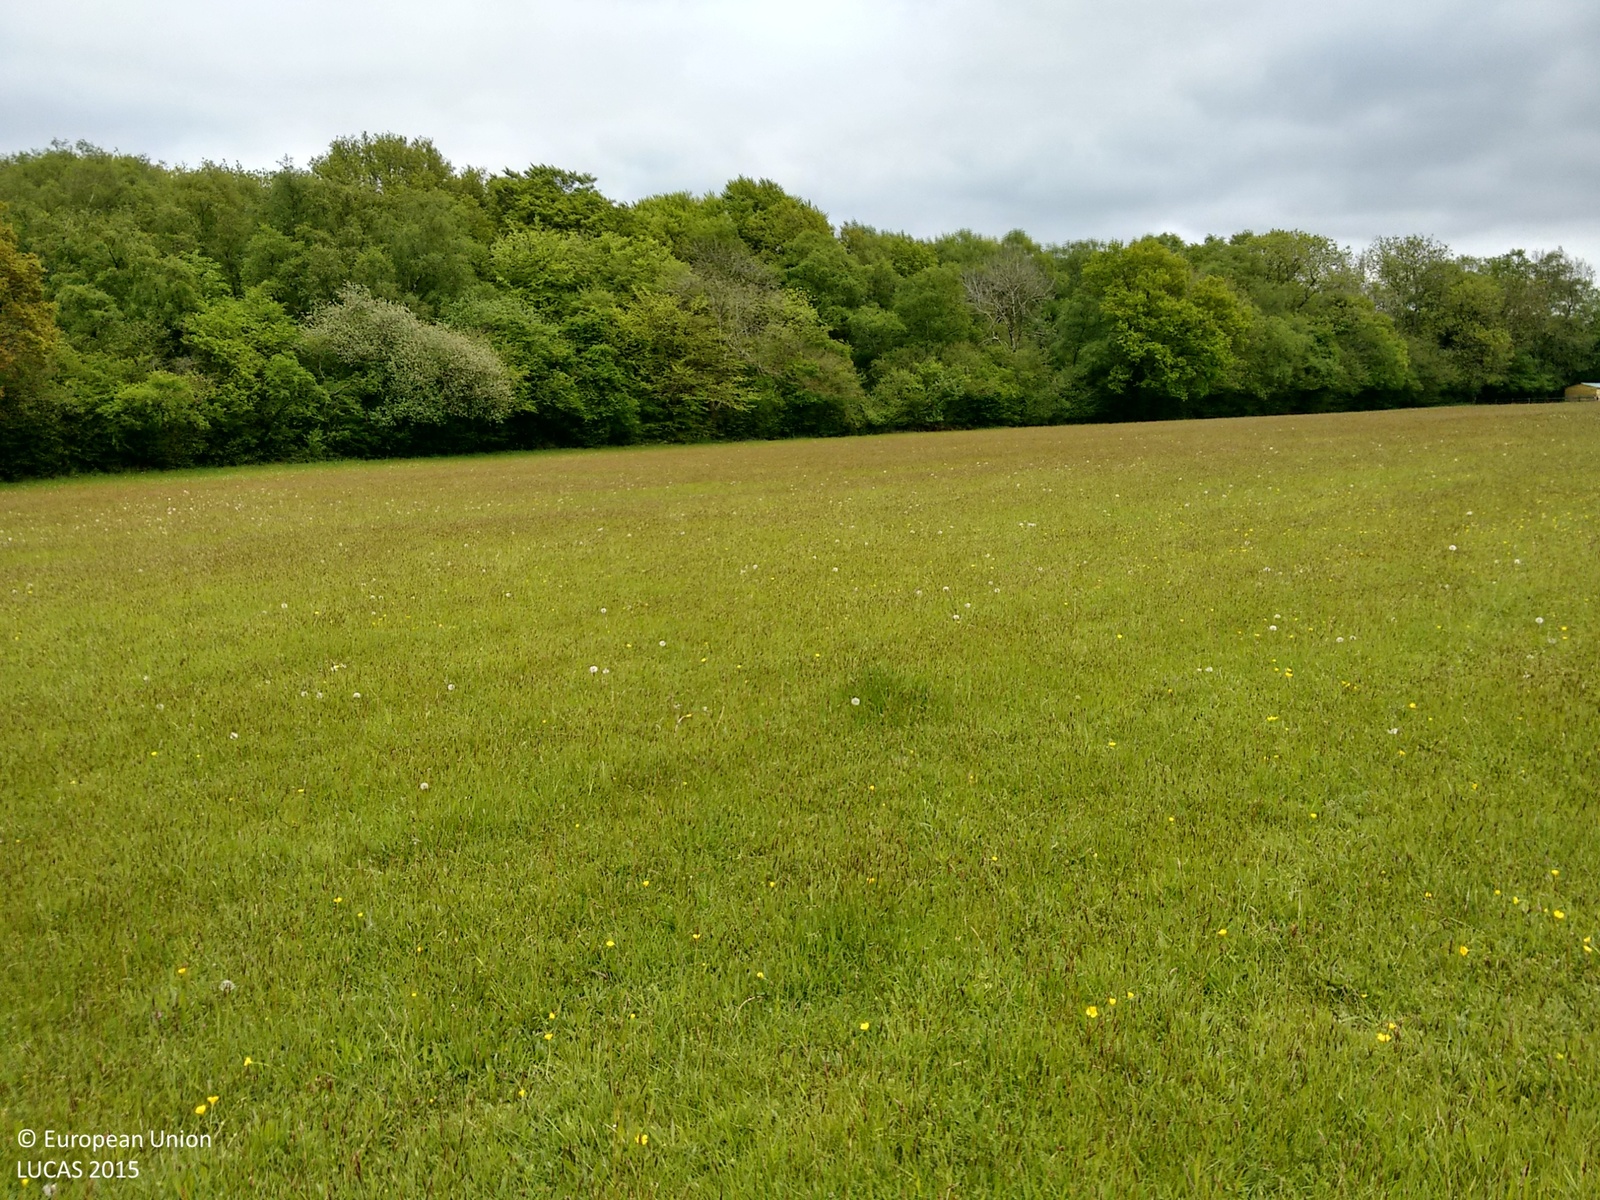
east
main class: Grassland
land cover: Grassland without tree/shrub cover
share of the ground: > 75 %
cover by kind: herbaceous plants 100 %
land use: Agriculture (excluding fallow land and kitchen gardens)
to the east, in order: Grassland without tree/shrub cover; Fences; Broadleaved woodland
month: May
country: GB
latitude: 51.0315
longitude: -0.9811
